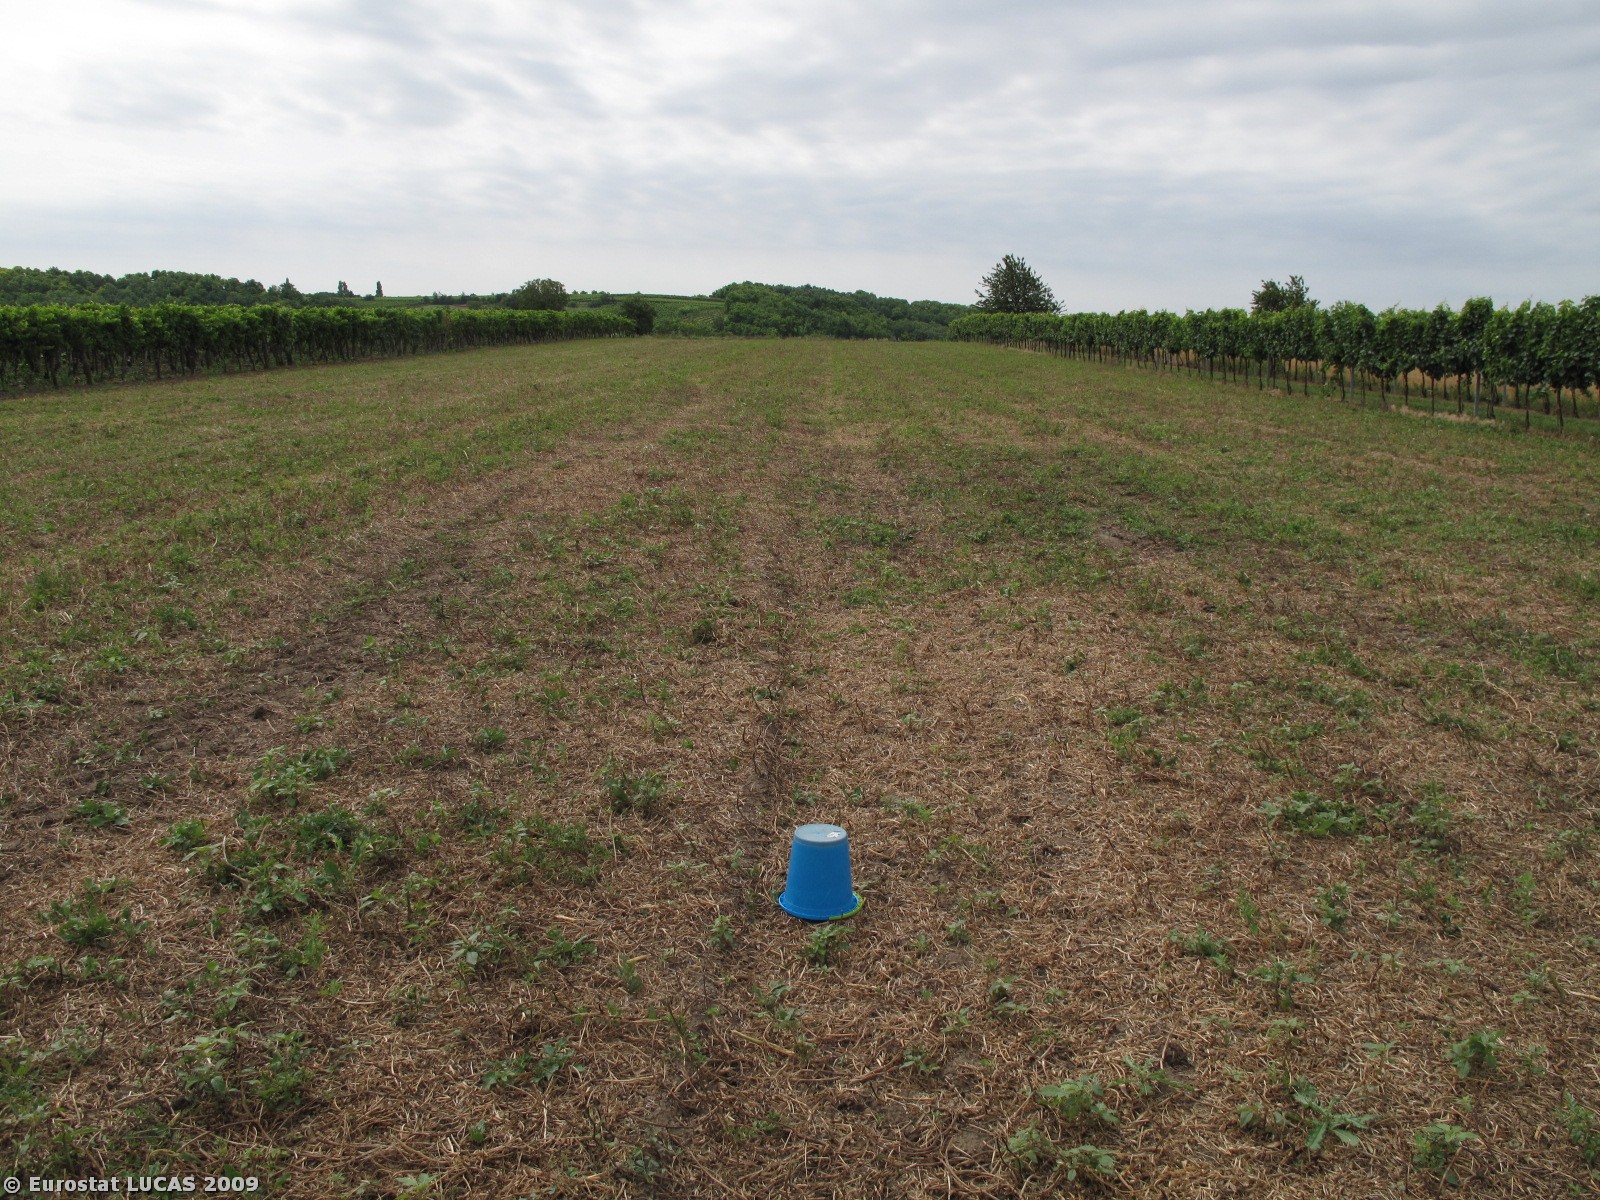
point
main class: Cropland
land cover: Dry pulses
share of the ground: 50 - 75 %
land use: Agriculture (excluding fallow land and kitchen gardens)
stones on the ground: < 10 %
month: May
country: AT
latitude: 48.6889
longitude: 16.0497
